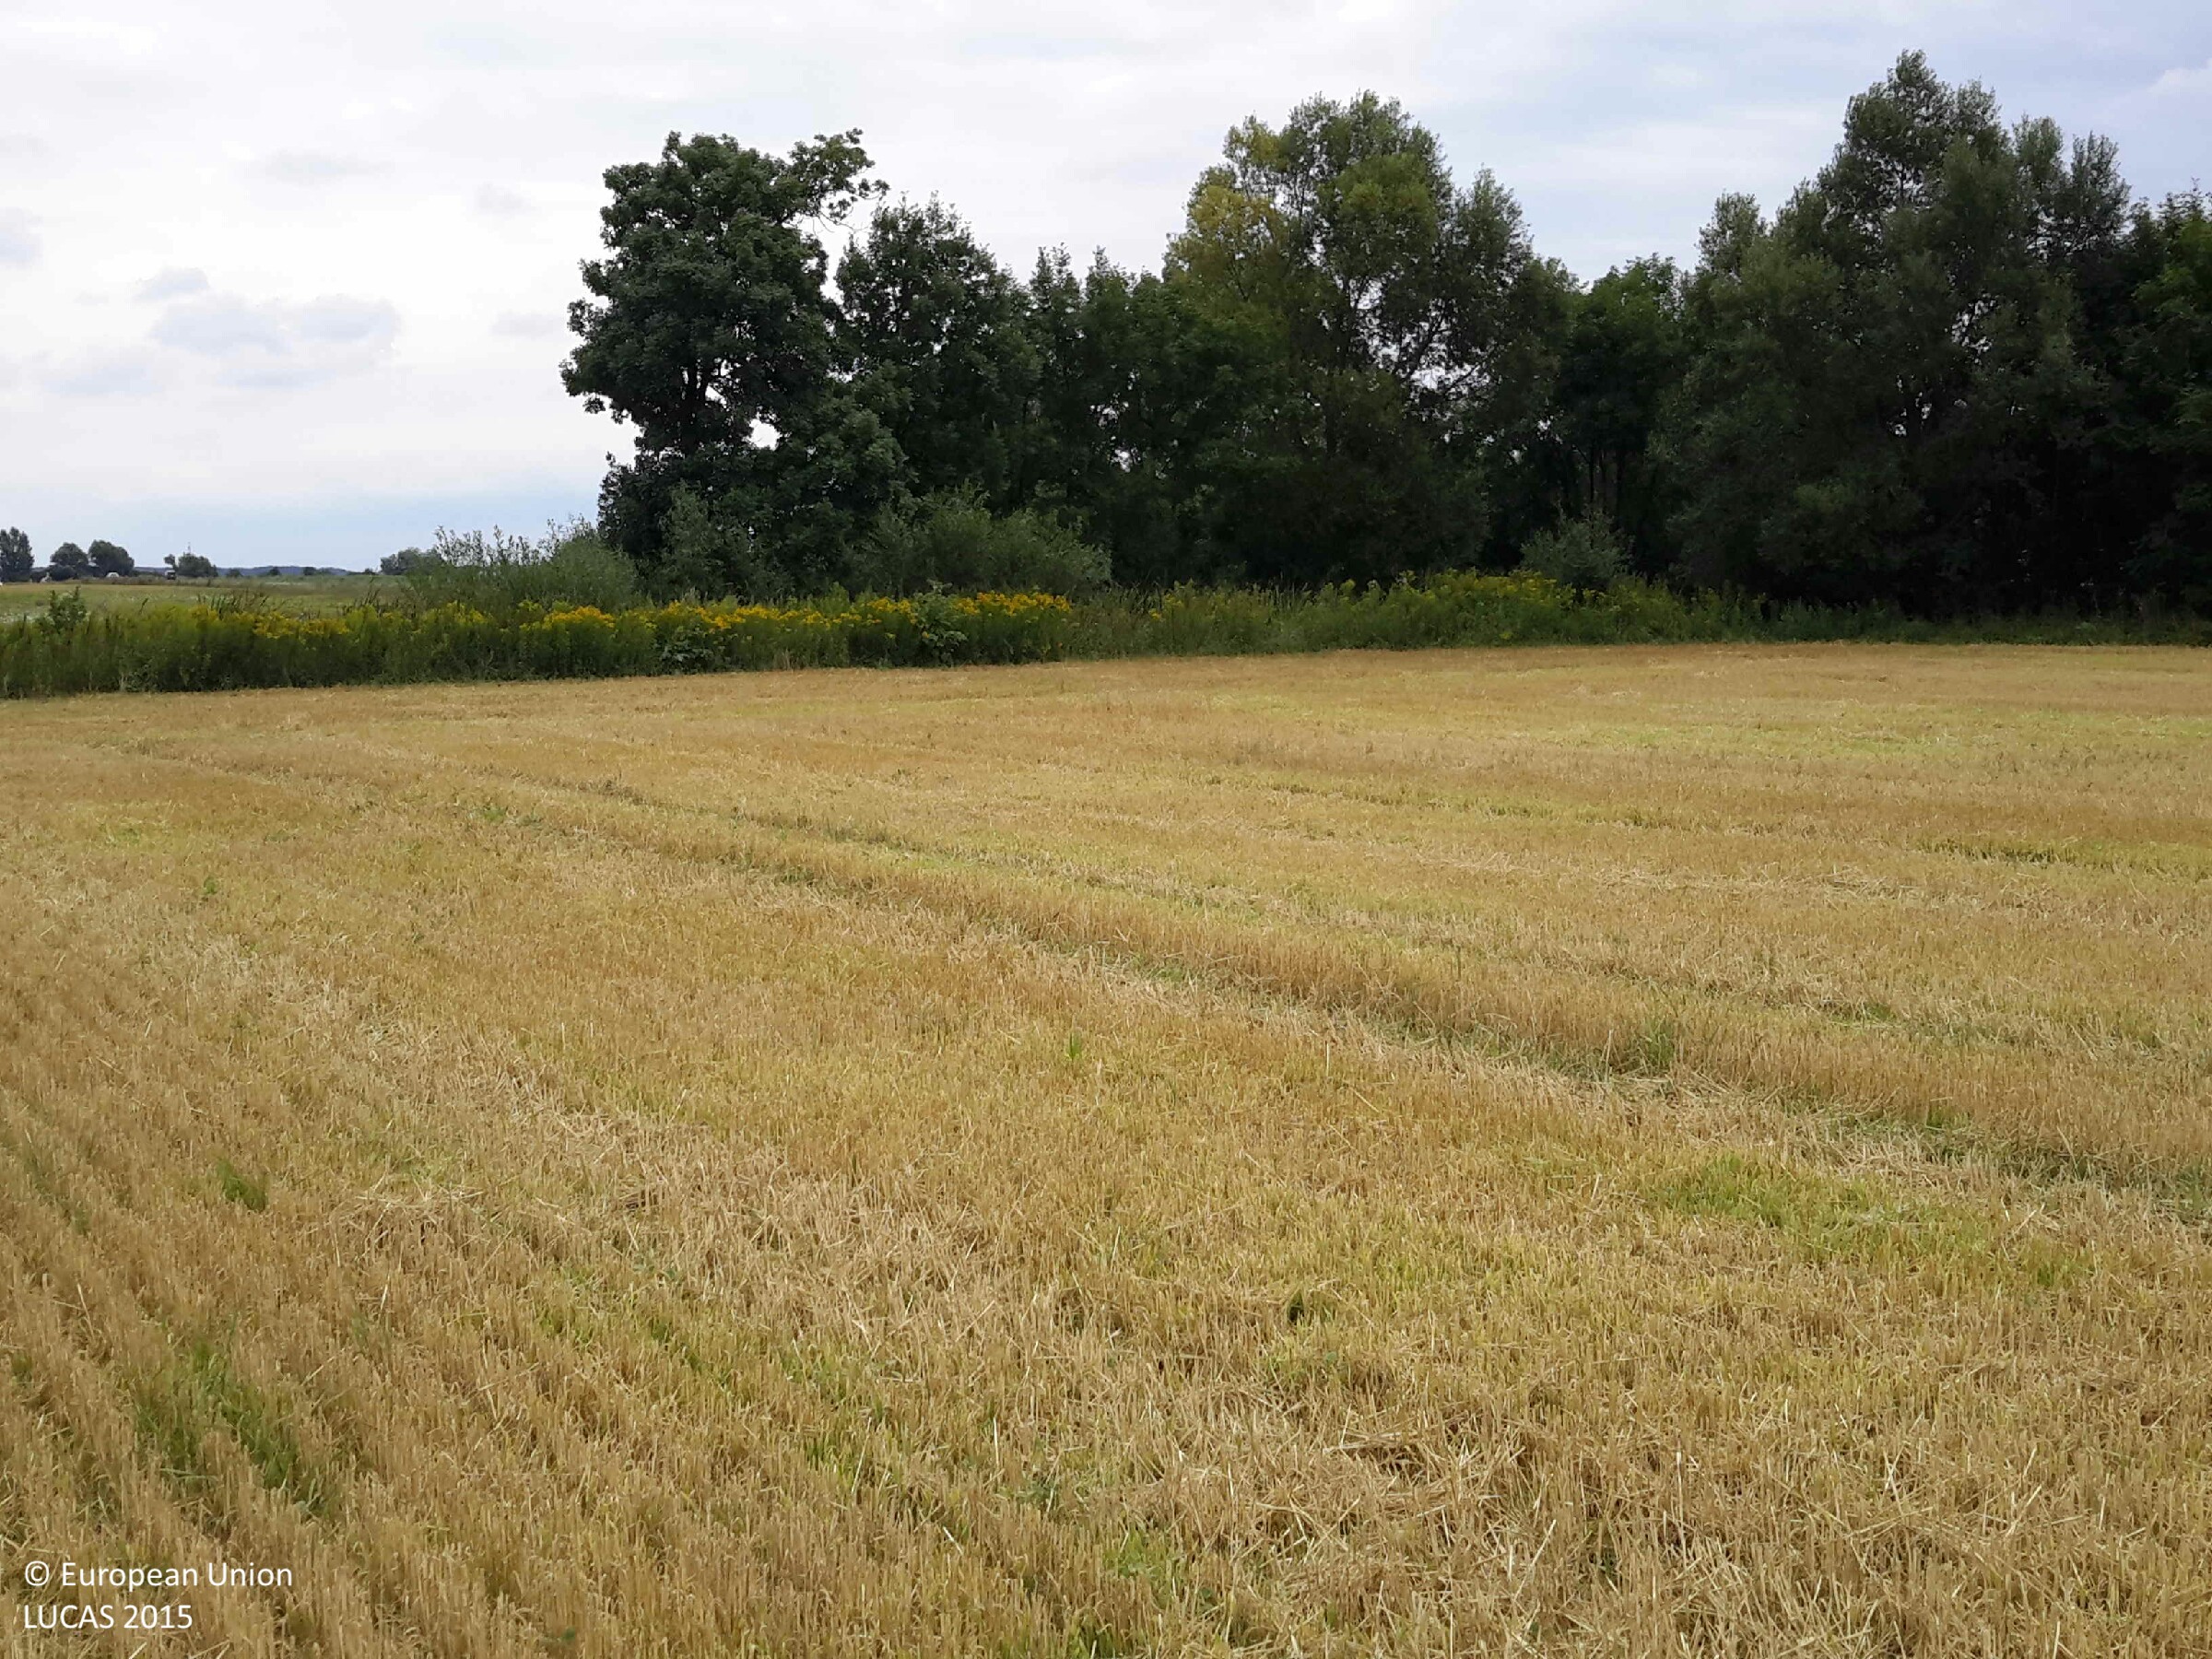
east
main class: Cropland
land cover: Common wheat
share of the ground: 50 - 75 %
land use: Agriculture (excluding fallow land and kitchen gardens)
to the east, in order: Common wheat; Abandoned hedges; Ditches and canals; Abandoned hedges; Grassland without tree/shrub cover; Ditches and canals; Grass margins; Paved roads, cycling and walking lanes; Grass margins; Ditches and canals; Shrubland without tree cover; Grassland without tree/shrub cover; Abandoned hedges; Grassland without tree/shrub cover
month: July
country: HU
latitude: 47.3000
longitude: 16.6561
